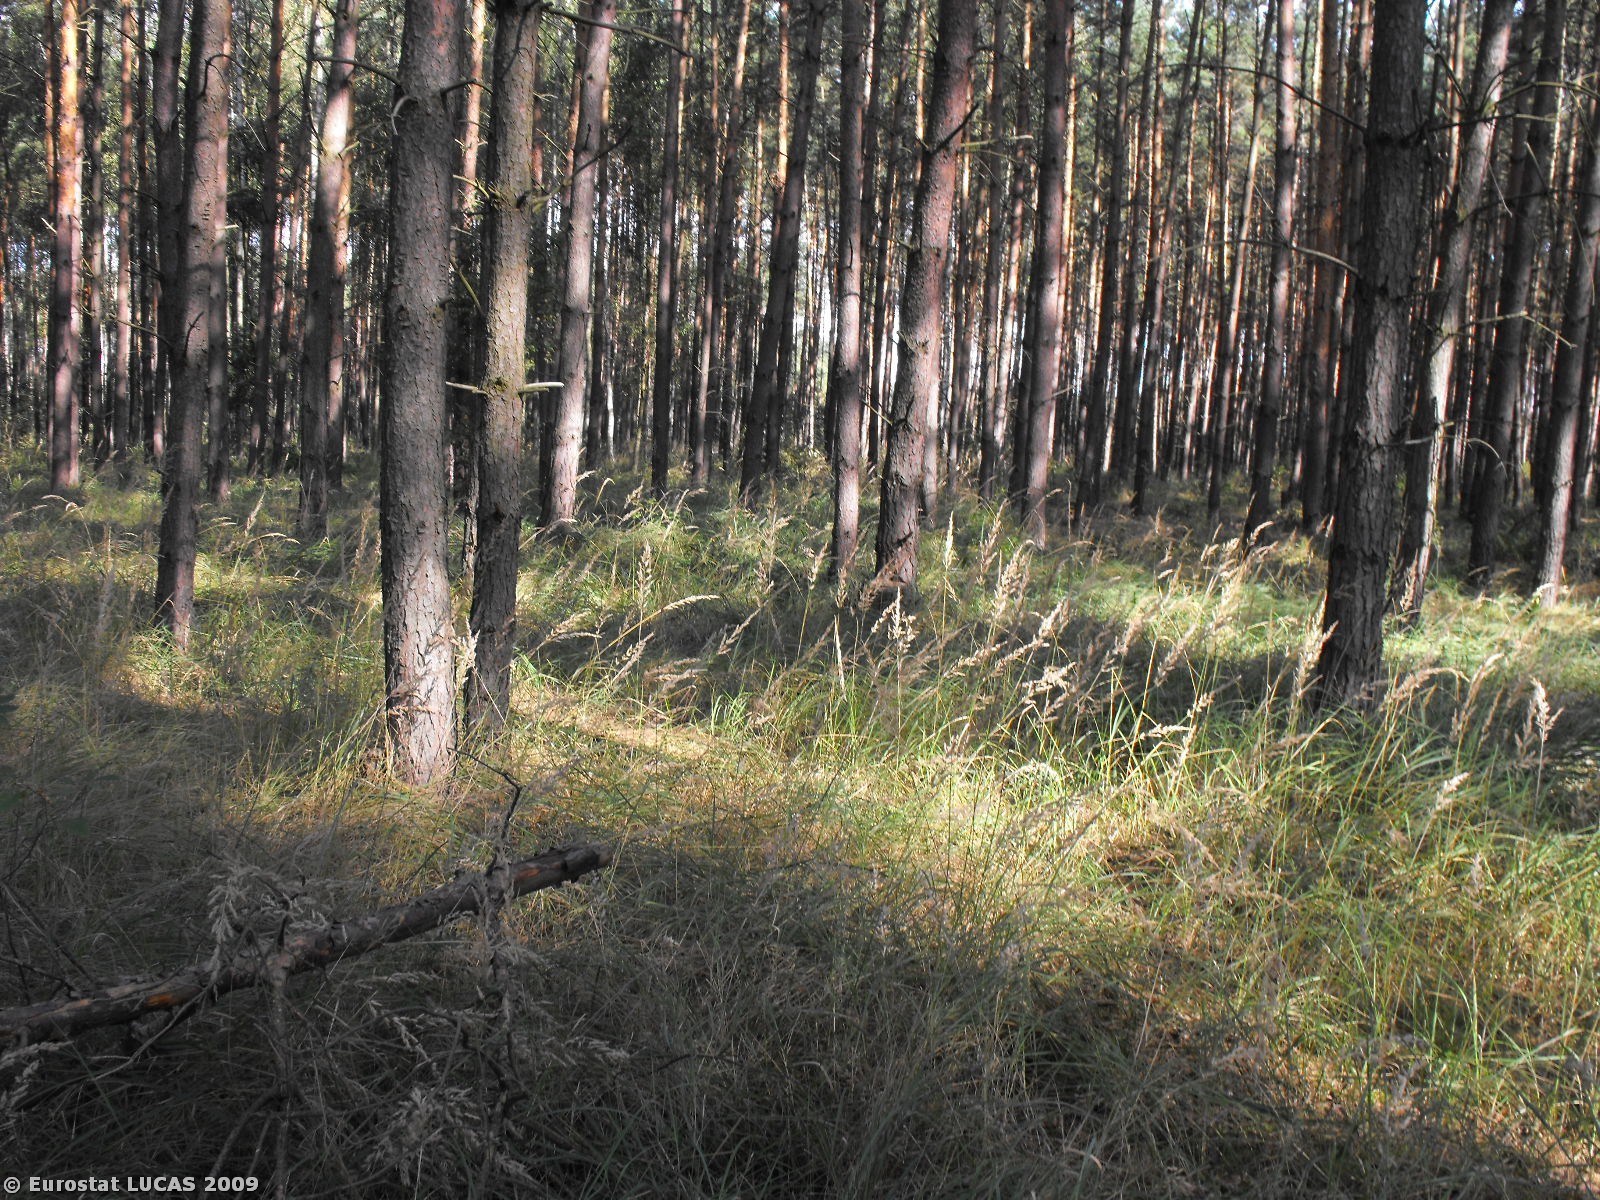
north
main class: Woodland
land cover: Coniferous woodland
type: hemiboreal forest and nemoral coniferous forest and mixed broadleaved-coniferous forest
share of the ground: > 75 %
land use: Forestry
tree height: > 5 m
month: September
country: PL
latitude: 52.3362
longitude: 16.3028
